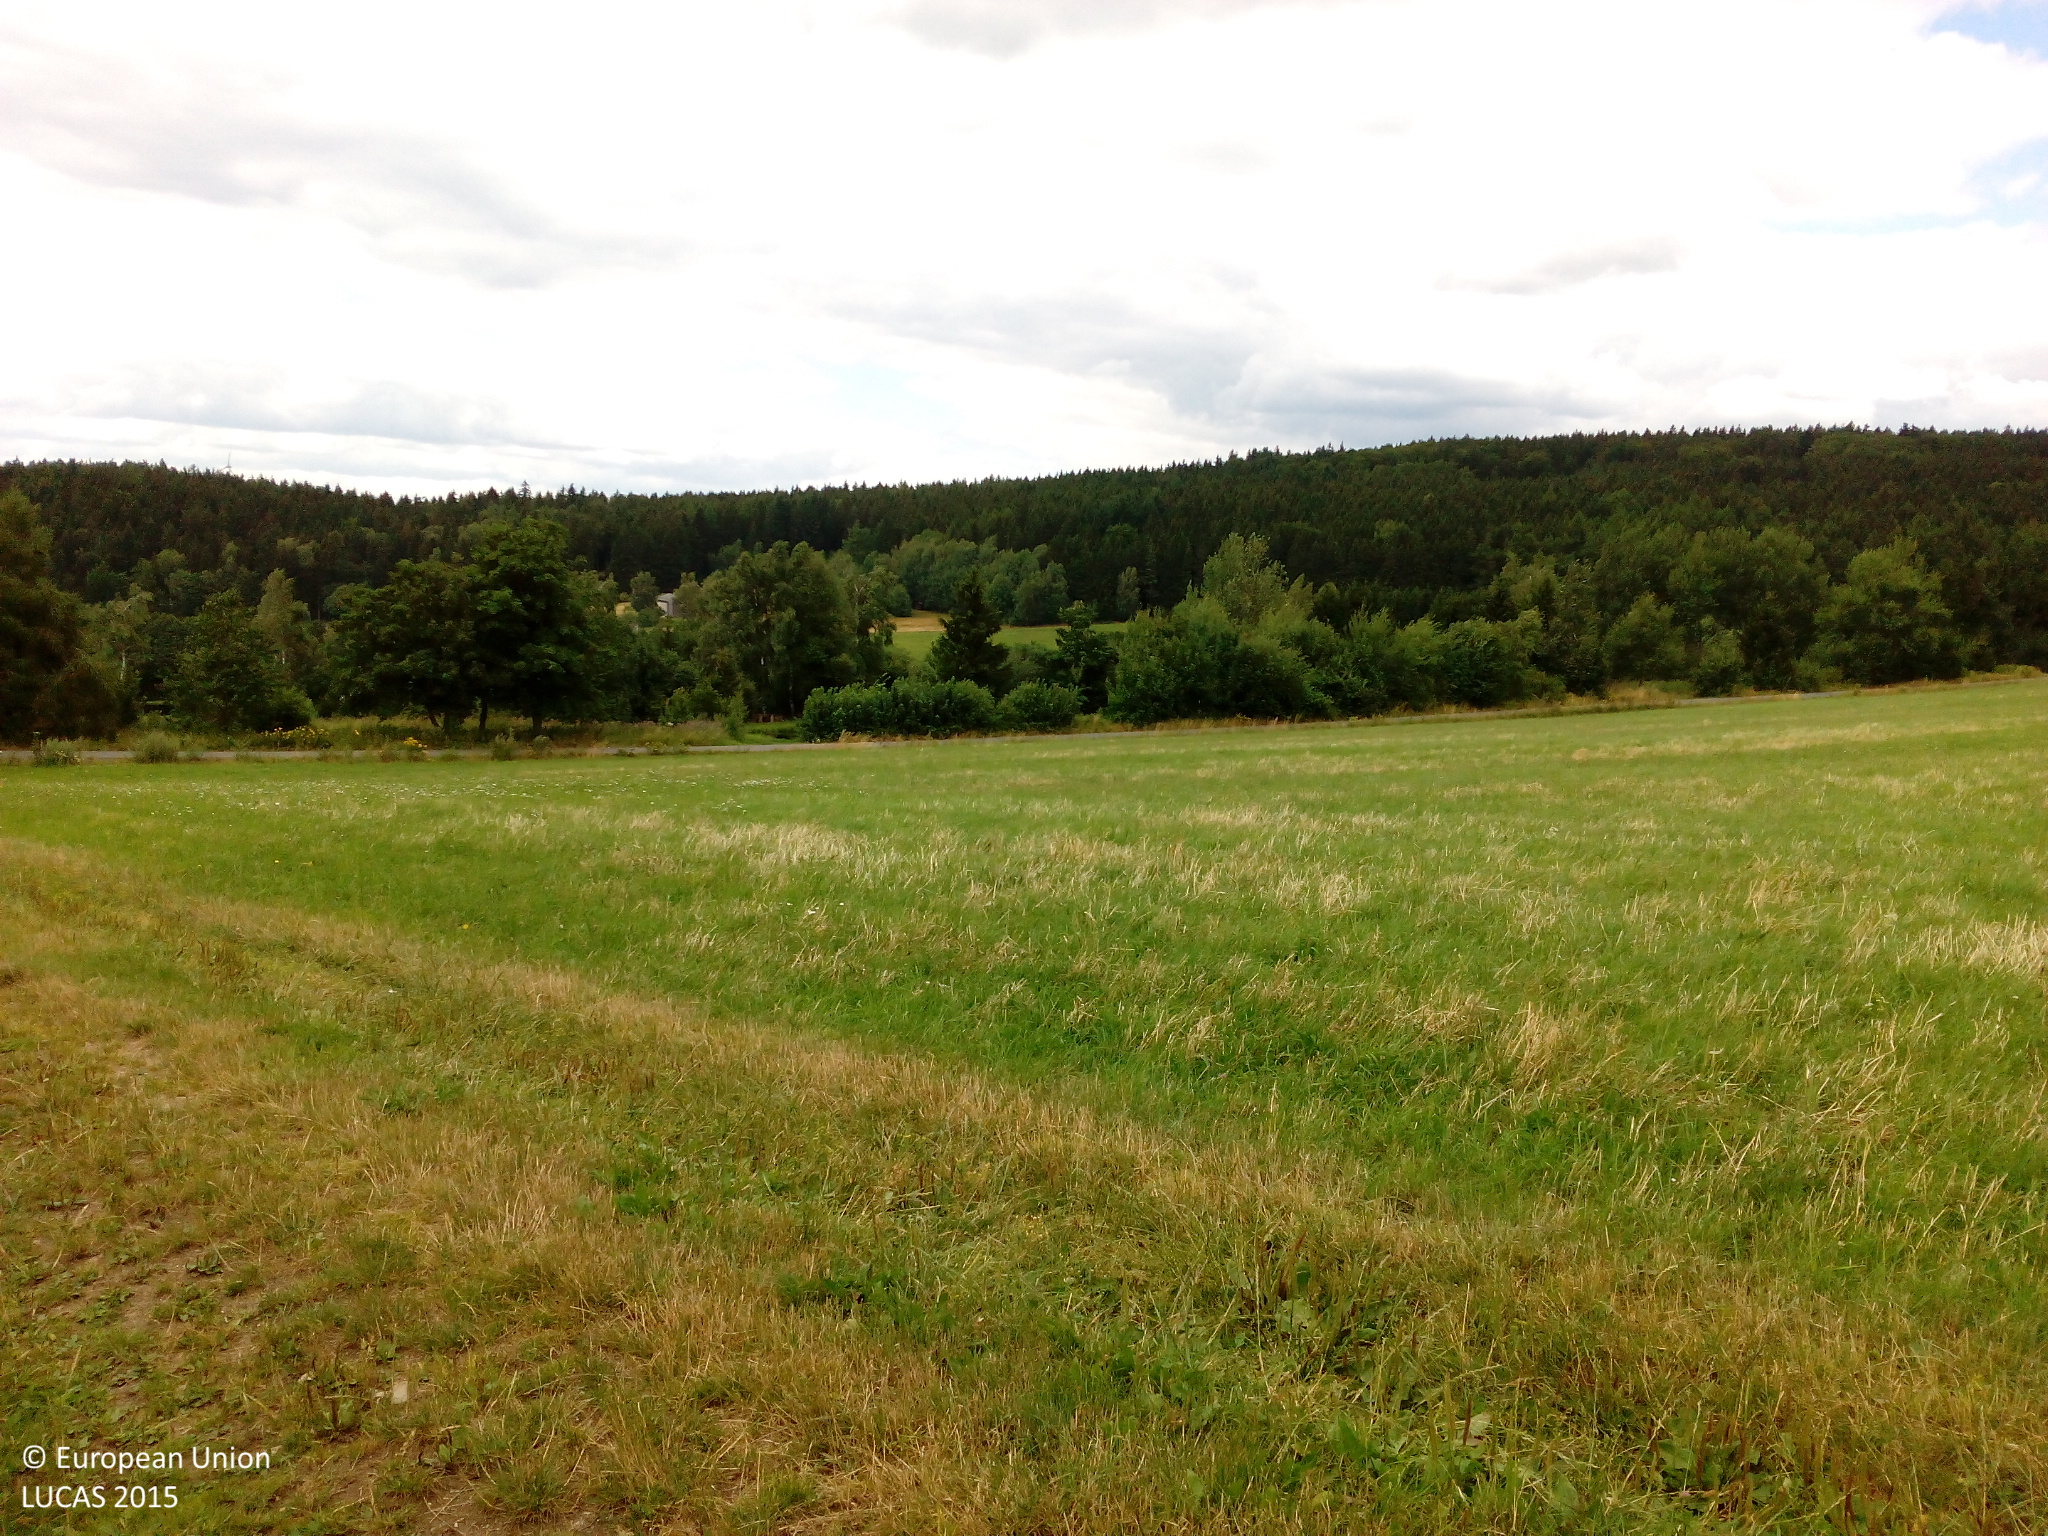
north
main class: Cropland
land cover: Maize
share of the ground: > 75 %
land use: Agriculture (excluding fallow land and kitchen gardens)
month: July
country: DE
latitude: 49.8159
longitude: 12.4596
